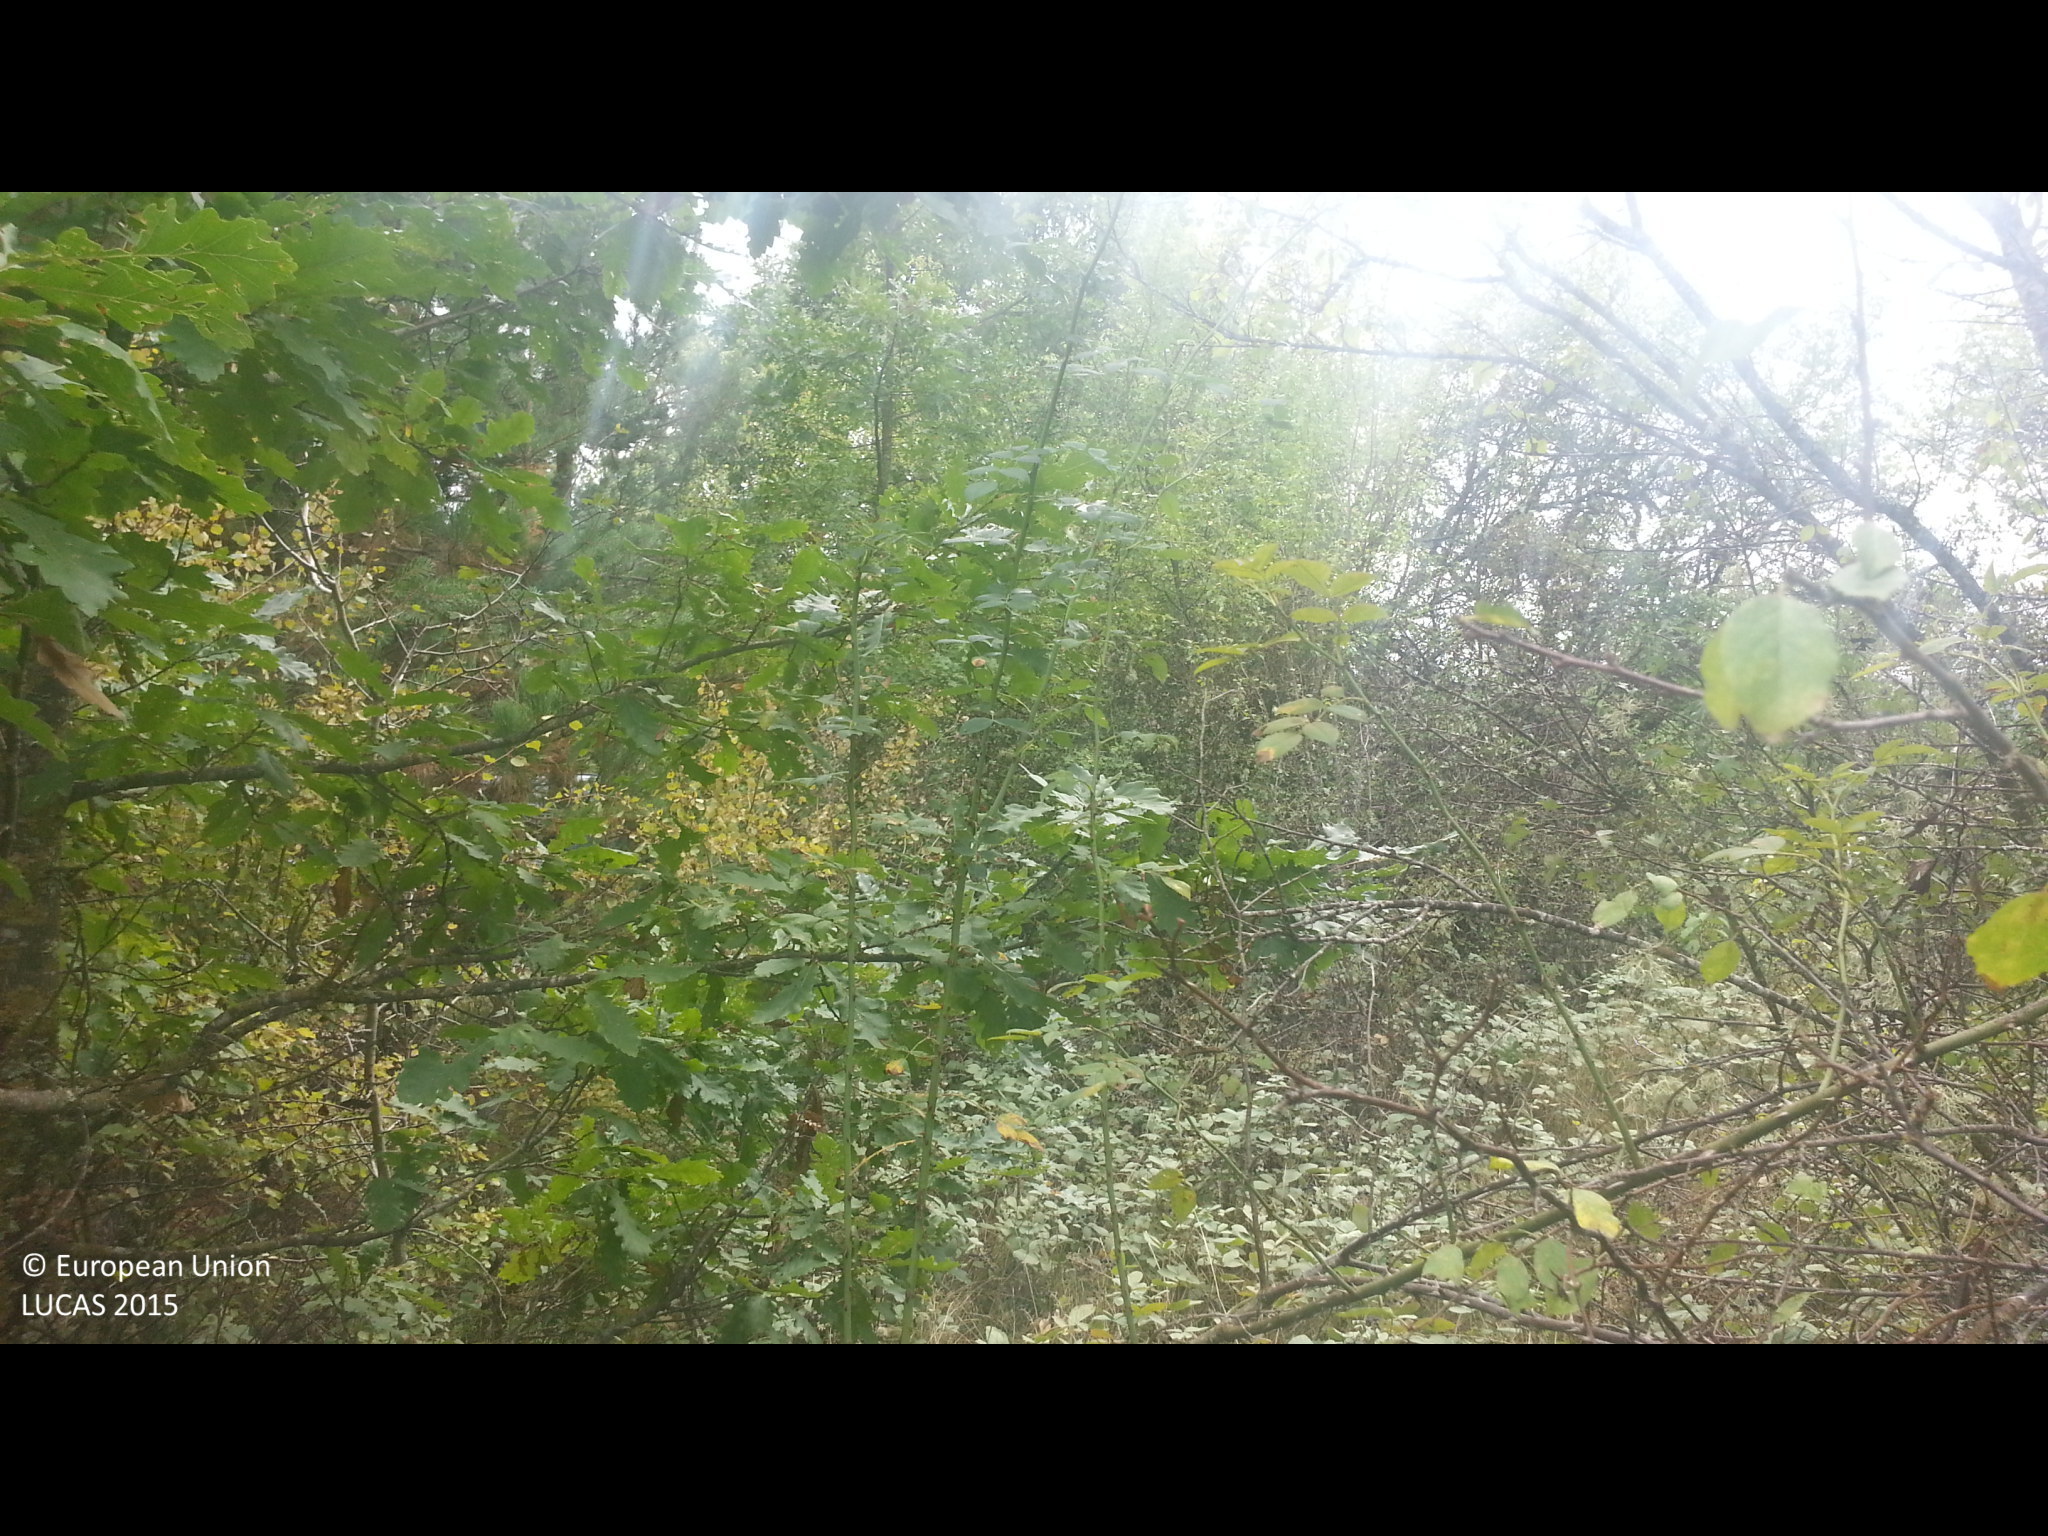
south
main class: Woodland
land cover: Other mixed woodland
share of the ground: > 75 %
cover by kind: broadleaved forest trees 70 %, coniferous forest trees 25 %, shrubs 5 %
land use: Forestry
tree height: < 5 m
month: September
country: BG
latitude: 42.5243
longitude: 22.5732
